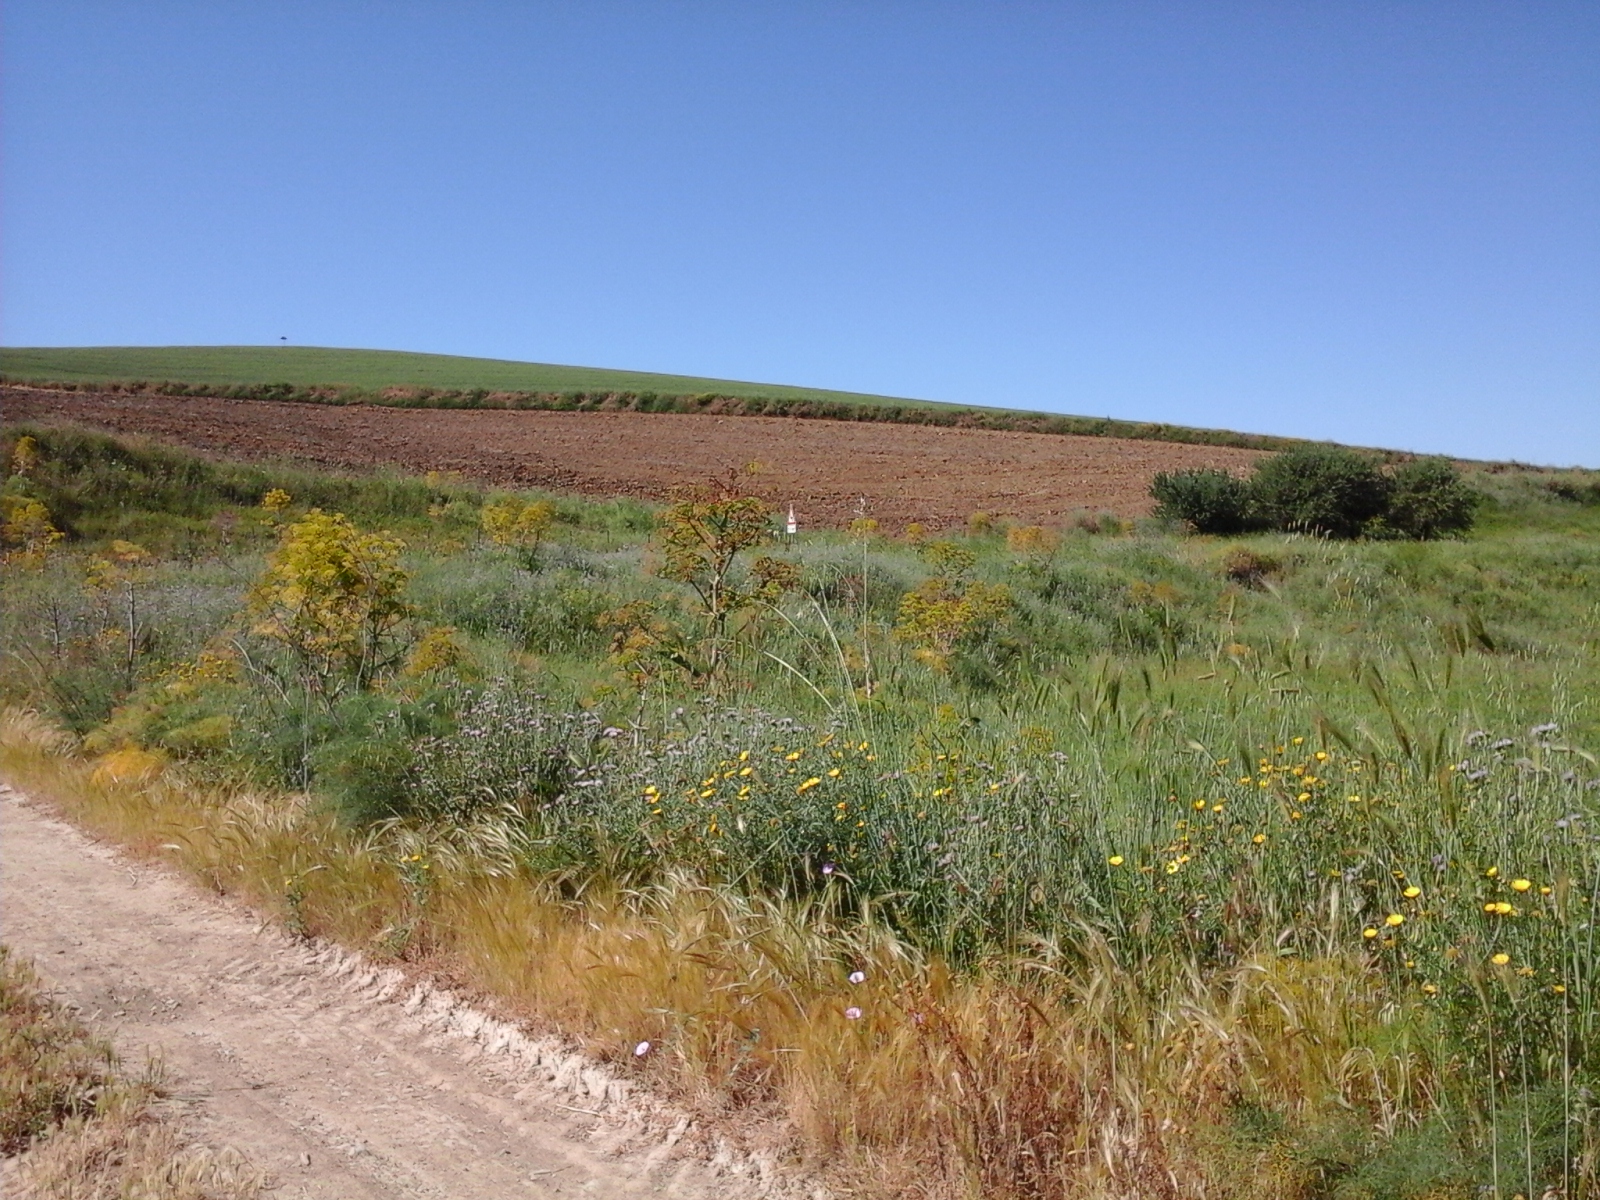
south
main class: Cropland
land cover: Other leguminous and mixtures for fodder
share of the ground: > 75 %
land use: Agriculture (excluding fallow land and kitchen gardens)
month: May
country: IT
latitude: 37.4917
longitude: 14.1875
